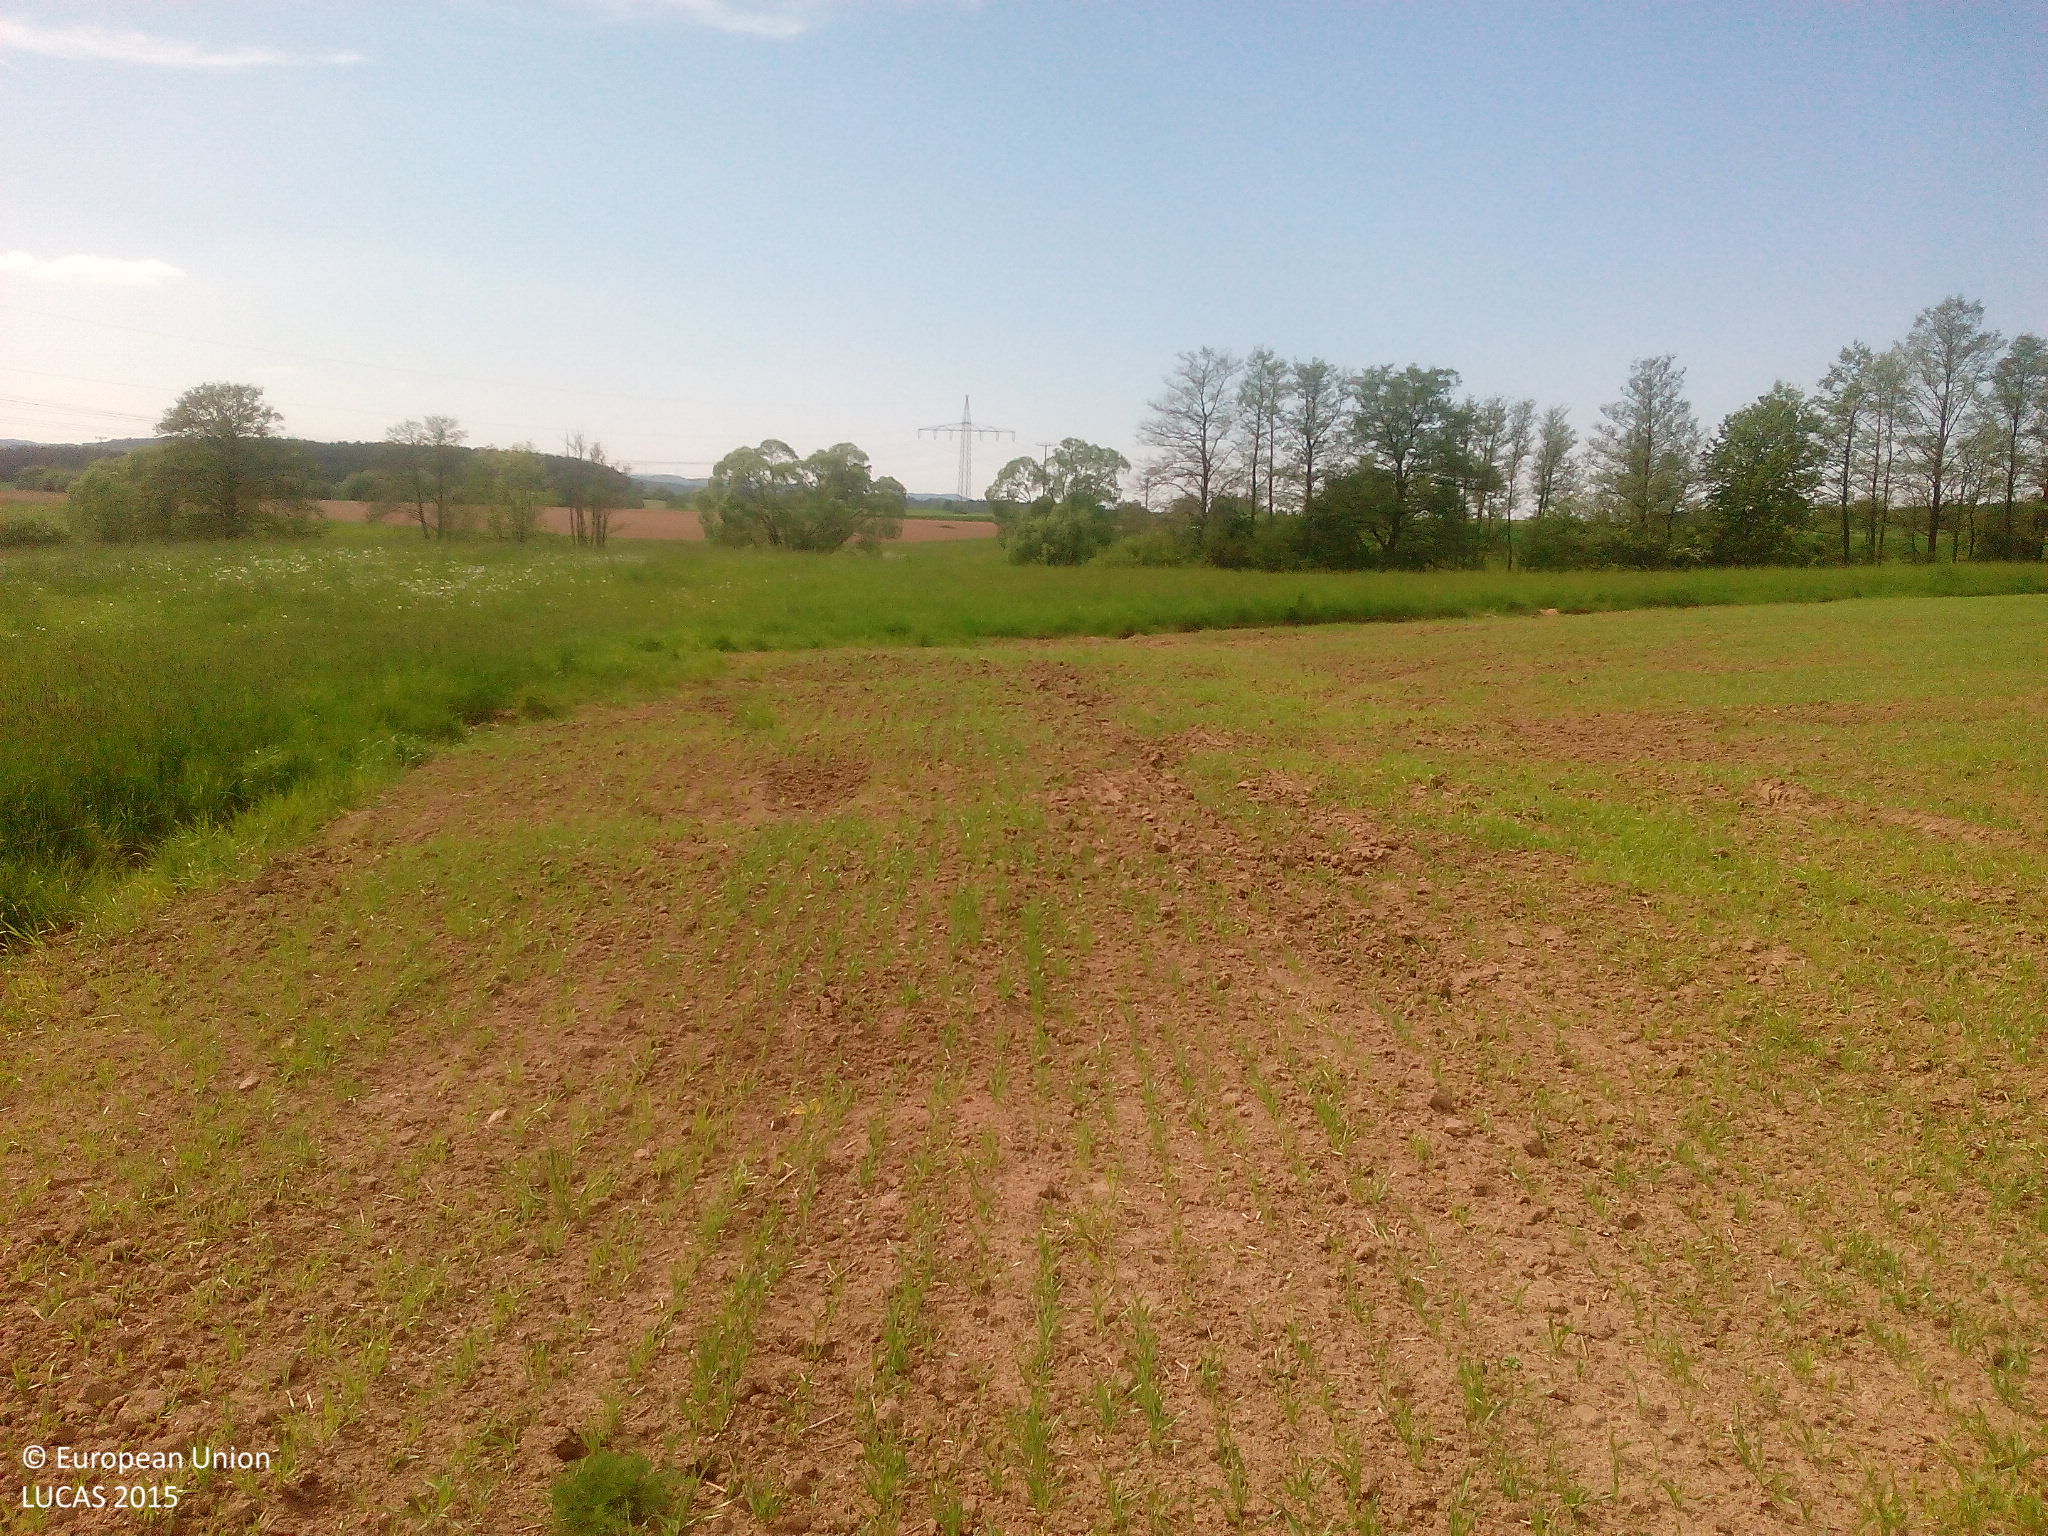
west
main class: Cropland
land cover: Common wheat
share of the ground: 25 - 50 %
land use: Agriculture (excluding fallow land and kitchen gardens)
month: May
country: DE
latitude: 50.0306
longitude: 11.4933
